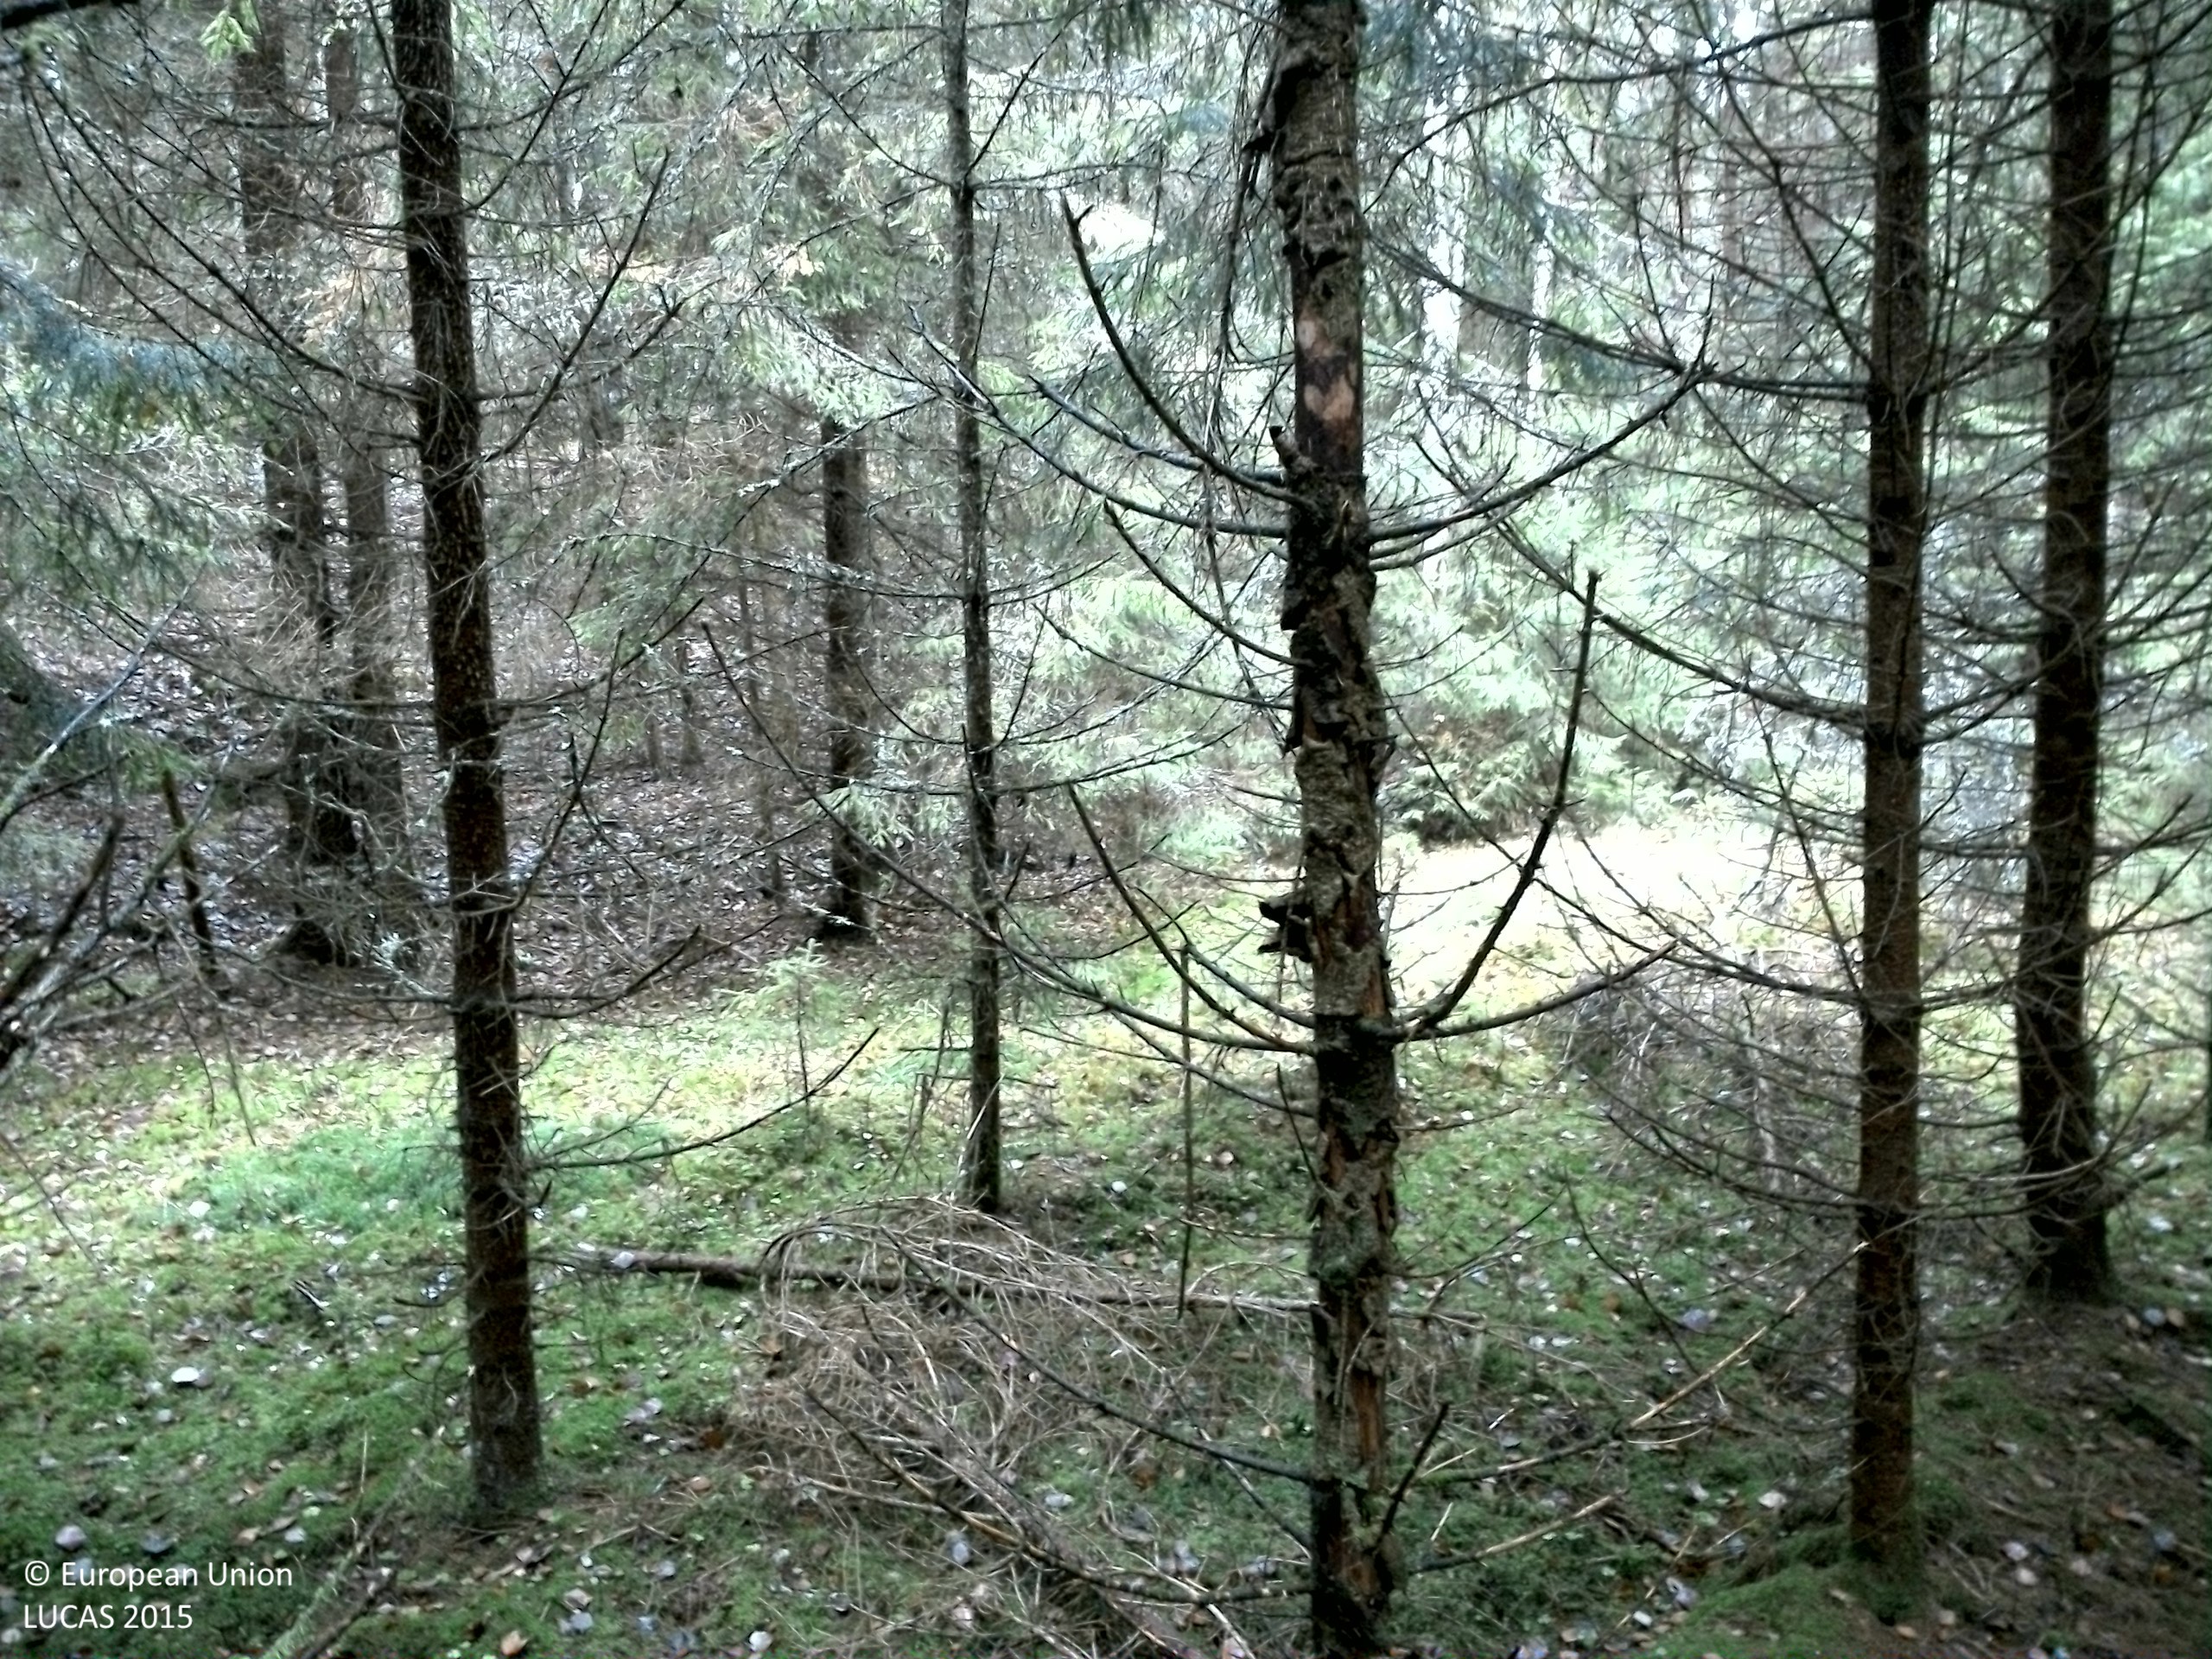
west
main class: Woodland
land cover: Spruce dominated coniferous woodland
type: boreal forest
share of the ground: > 75 %
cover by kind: coniferous forest trees 75 %, lichens and mosses 20 %, shrubs 5 %
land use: Forestry
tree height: > 5 m
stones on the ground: < 10 %
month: November
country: SE
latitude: 57.6930
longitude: 15.4820
